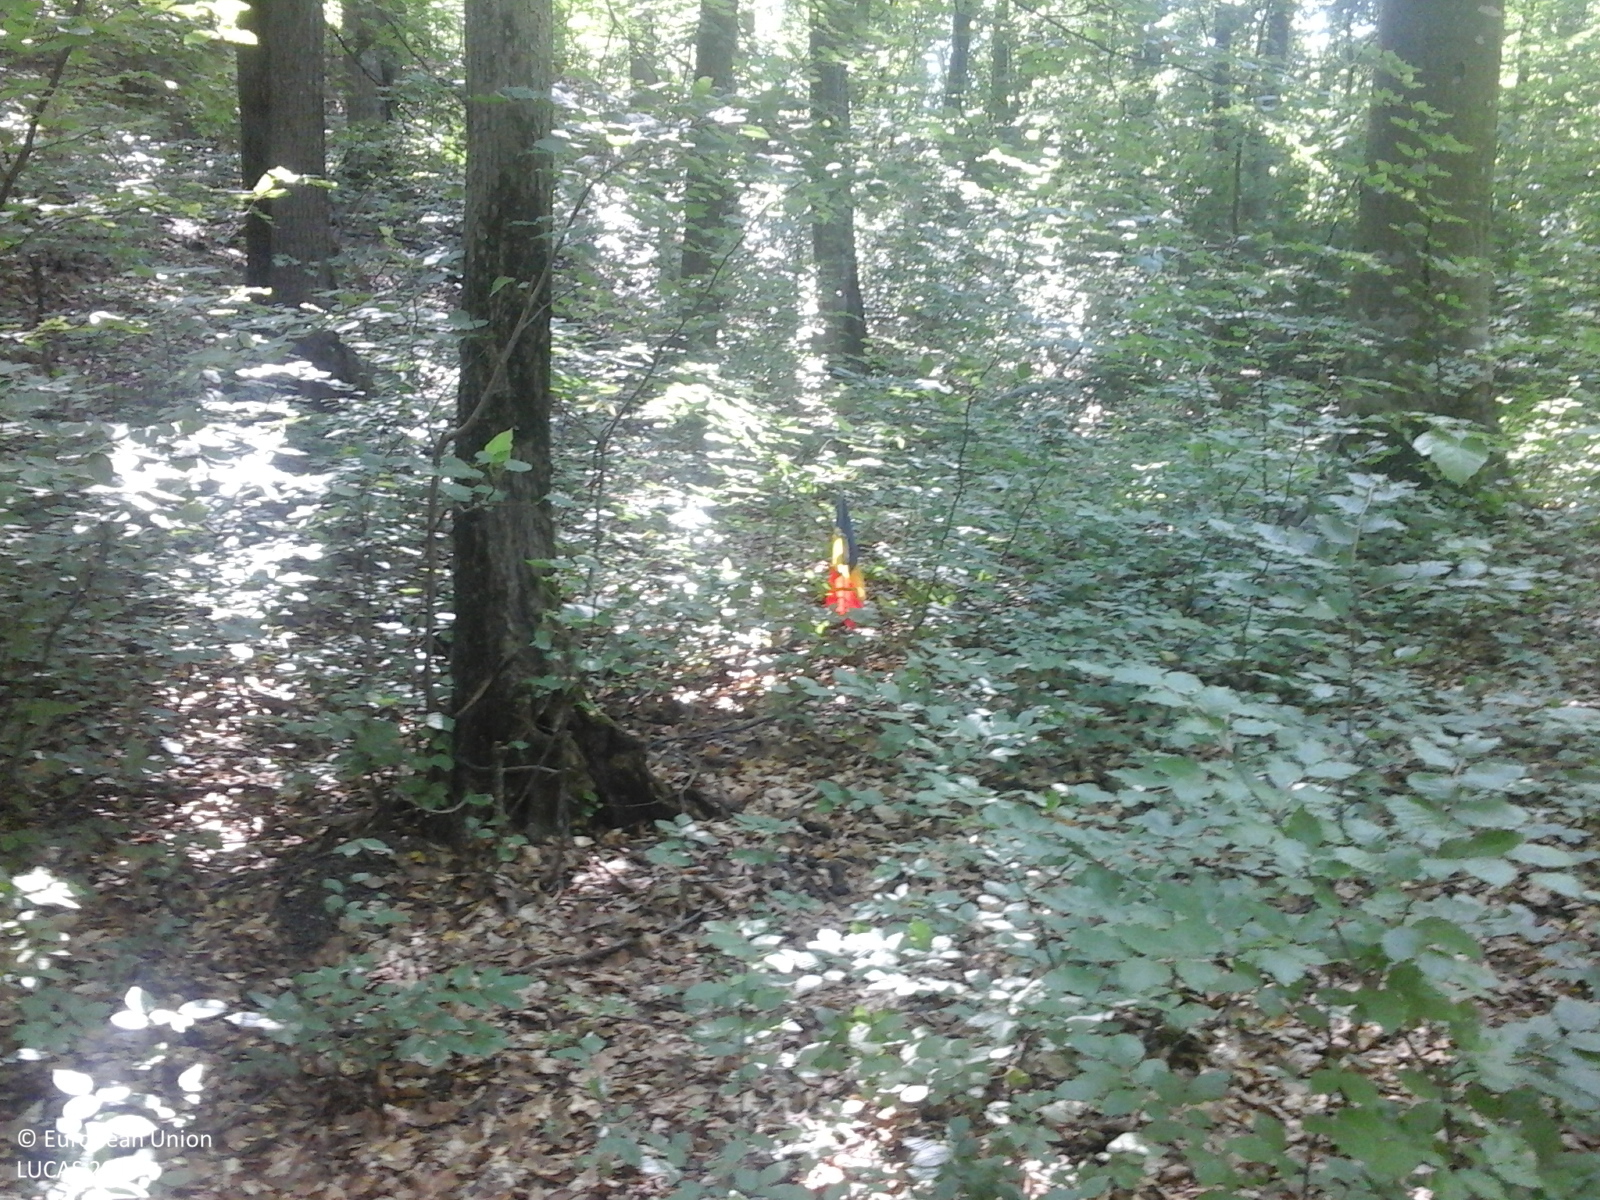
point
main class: Woodland
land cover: Broadleaved woodland
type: beech forest
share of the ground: > 75 %
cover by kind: broadleaved forest trees 90 %, shrubs 5 %, herbaceous plants 5 %
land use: Forestry
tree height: > 5 m
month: June
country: RO
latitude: 46.9009
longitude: 27.0471
